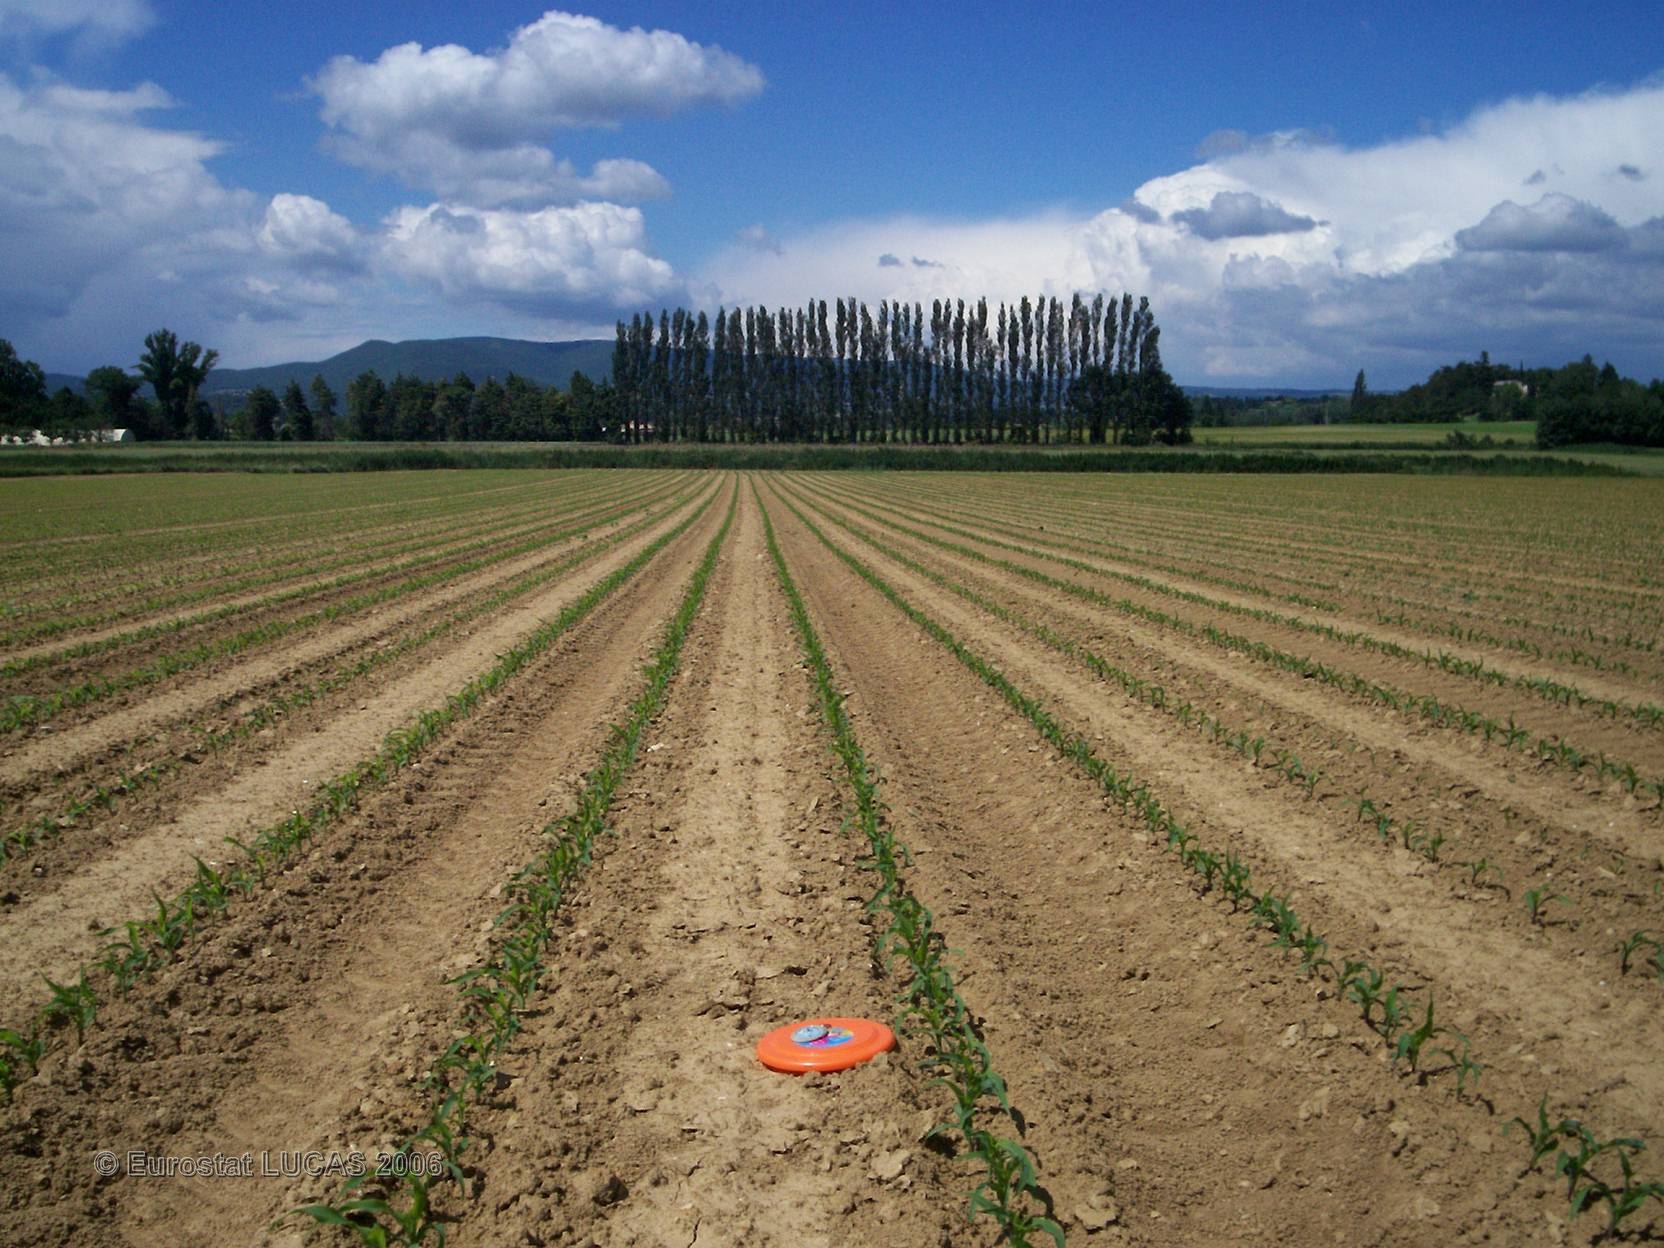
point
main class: Cropland
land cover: Maize
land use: Agriculture (excluding fallow land and kitchen gardens)
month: May
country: FR
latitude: 44.5663
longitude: 4.8569
